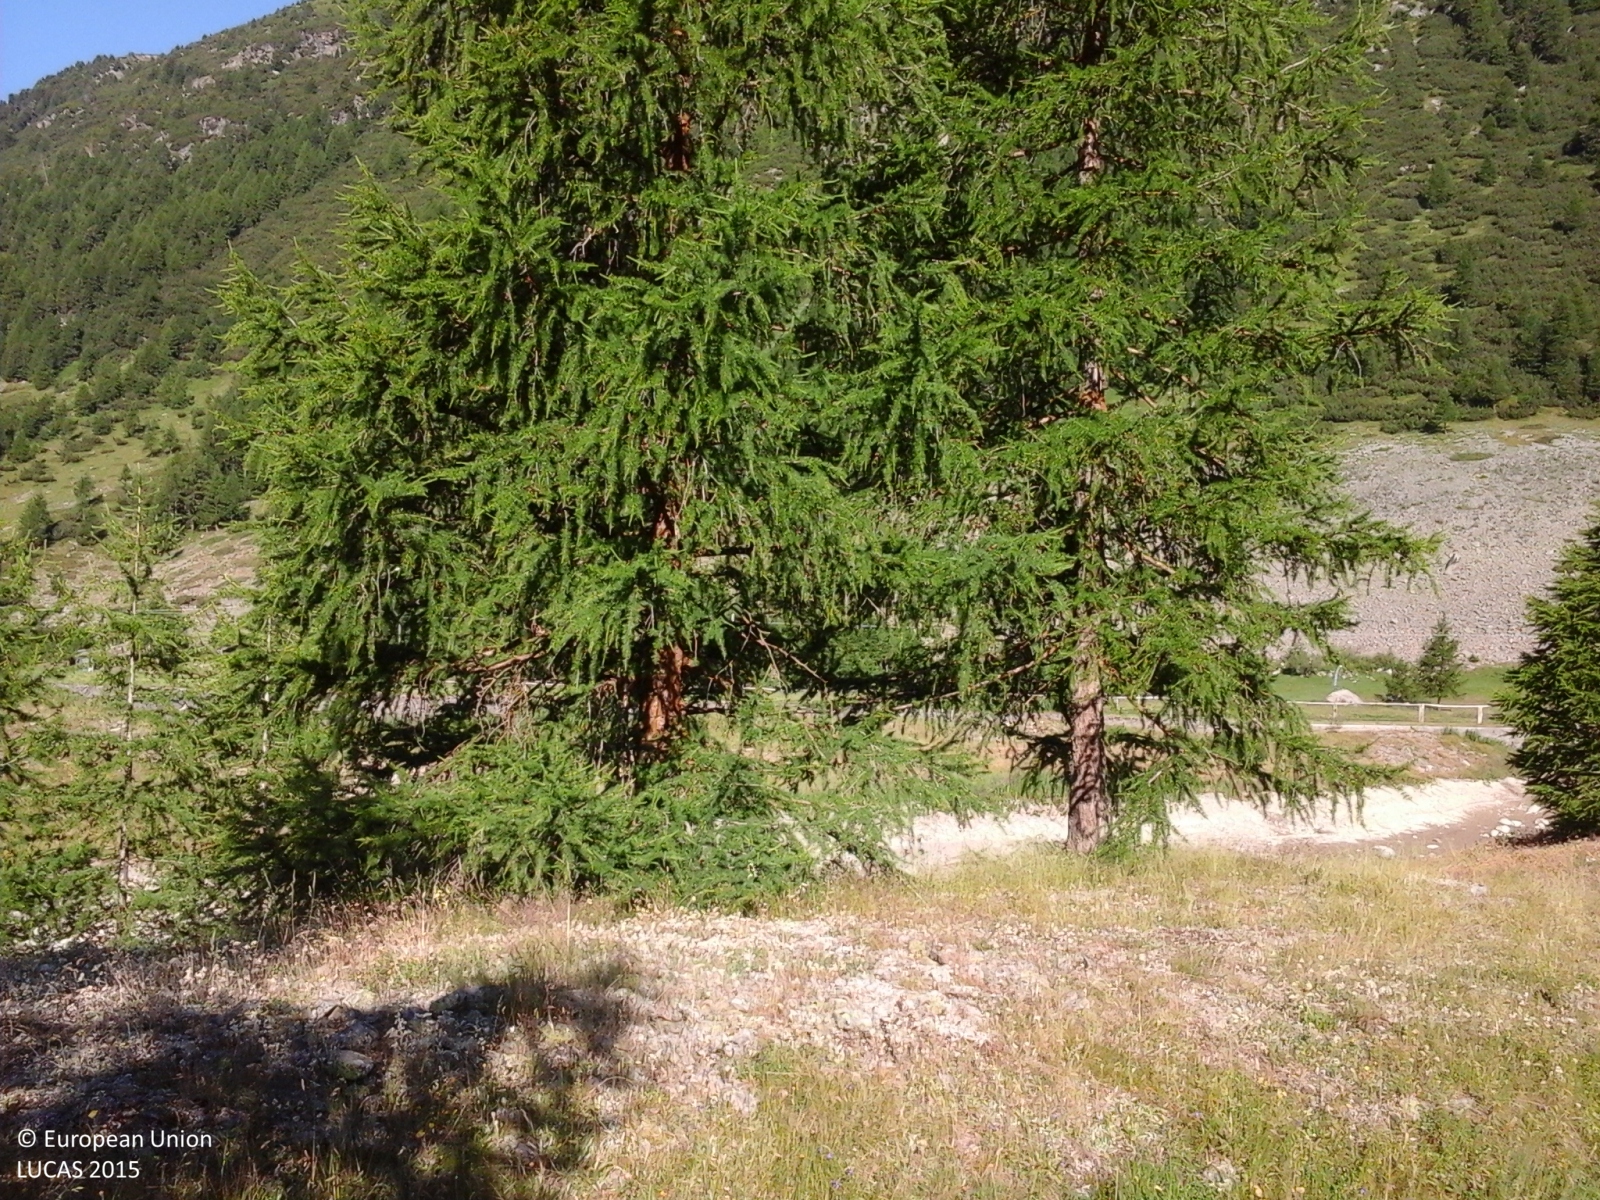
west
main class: Woodland
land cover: Other coniferous woodland
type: alpine coniferous forest
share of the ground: > 75 %
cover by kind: herbaceous plants 80 %, coniferous forest trees 20 %
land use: Agriculture (excluding fallow land and kitchen gardens)
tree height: > 5 m
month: July
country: IT
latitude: 46.4952
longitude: 10.1171
